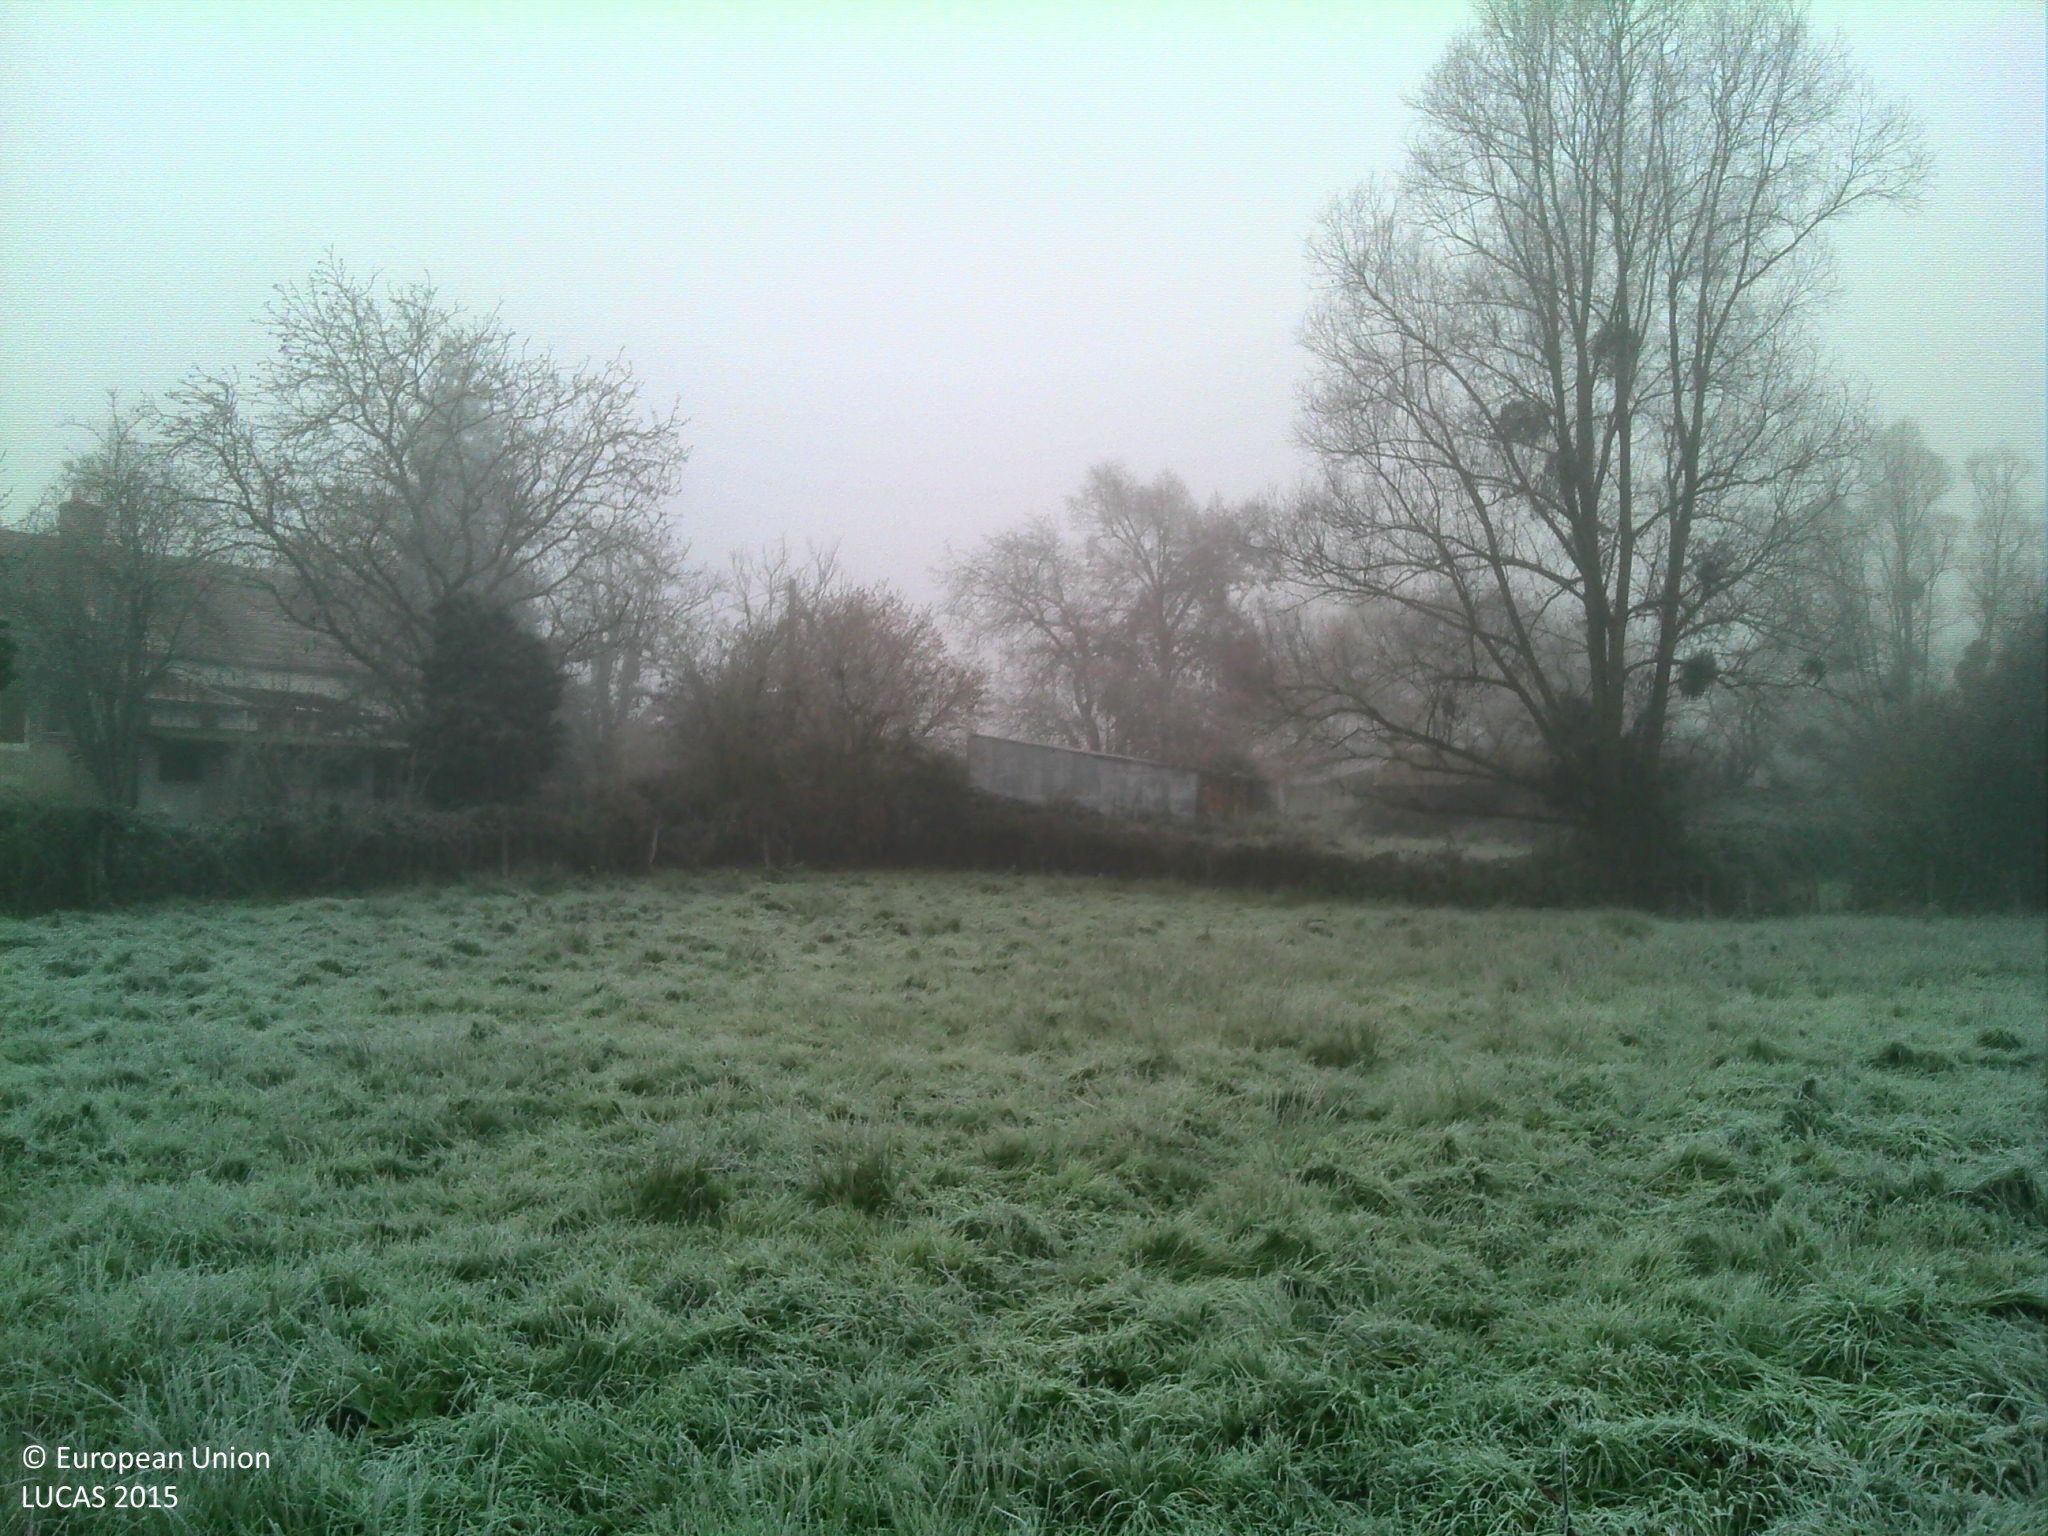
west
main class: Grassland
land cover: Grassland without tree/shrub cover
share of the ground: > 75 %
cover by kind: herbaceous plants 100 %
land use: Agriculture (excluding fallow land and kitchen gardens)
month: November
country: FR
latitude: 46.5792
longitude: 3.6703
